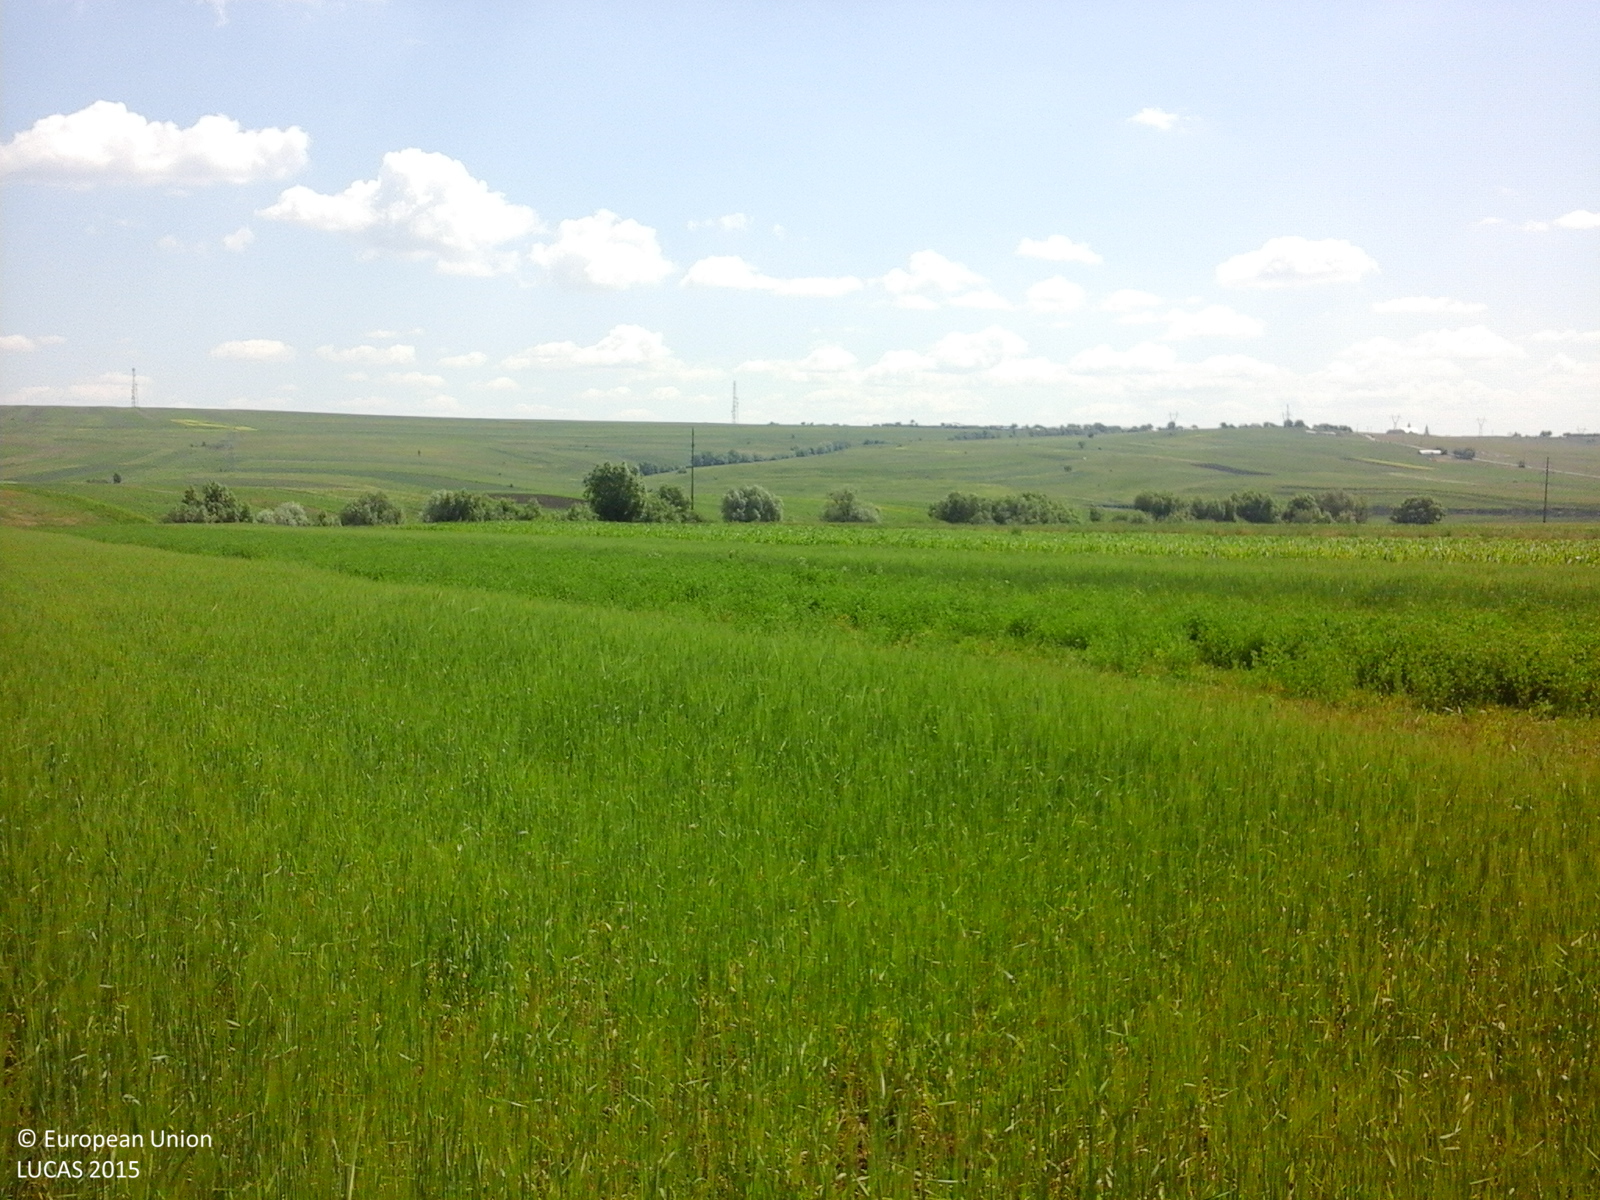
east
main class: Cropland
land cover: Barley
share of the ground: > 75 %
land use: Agriculture (excluding fallow land and kitchen gardens)
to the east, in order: Barley; Lucerne; Barley; Potatoes; Maize; Sunflower; Other leguminous and mixtures for fodder; Tracks; Other leguminous and mixtures for fodder; Single bushes/trees; Other leguminous and mixtures for fodder
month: June
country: RO
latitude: 47.5918
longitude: 26.2672
